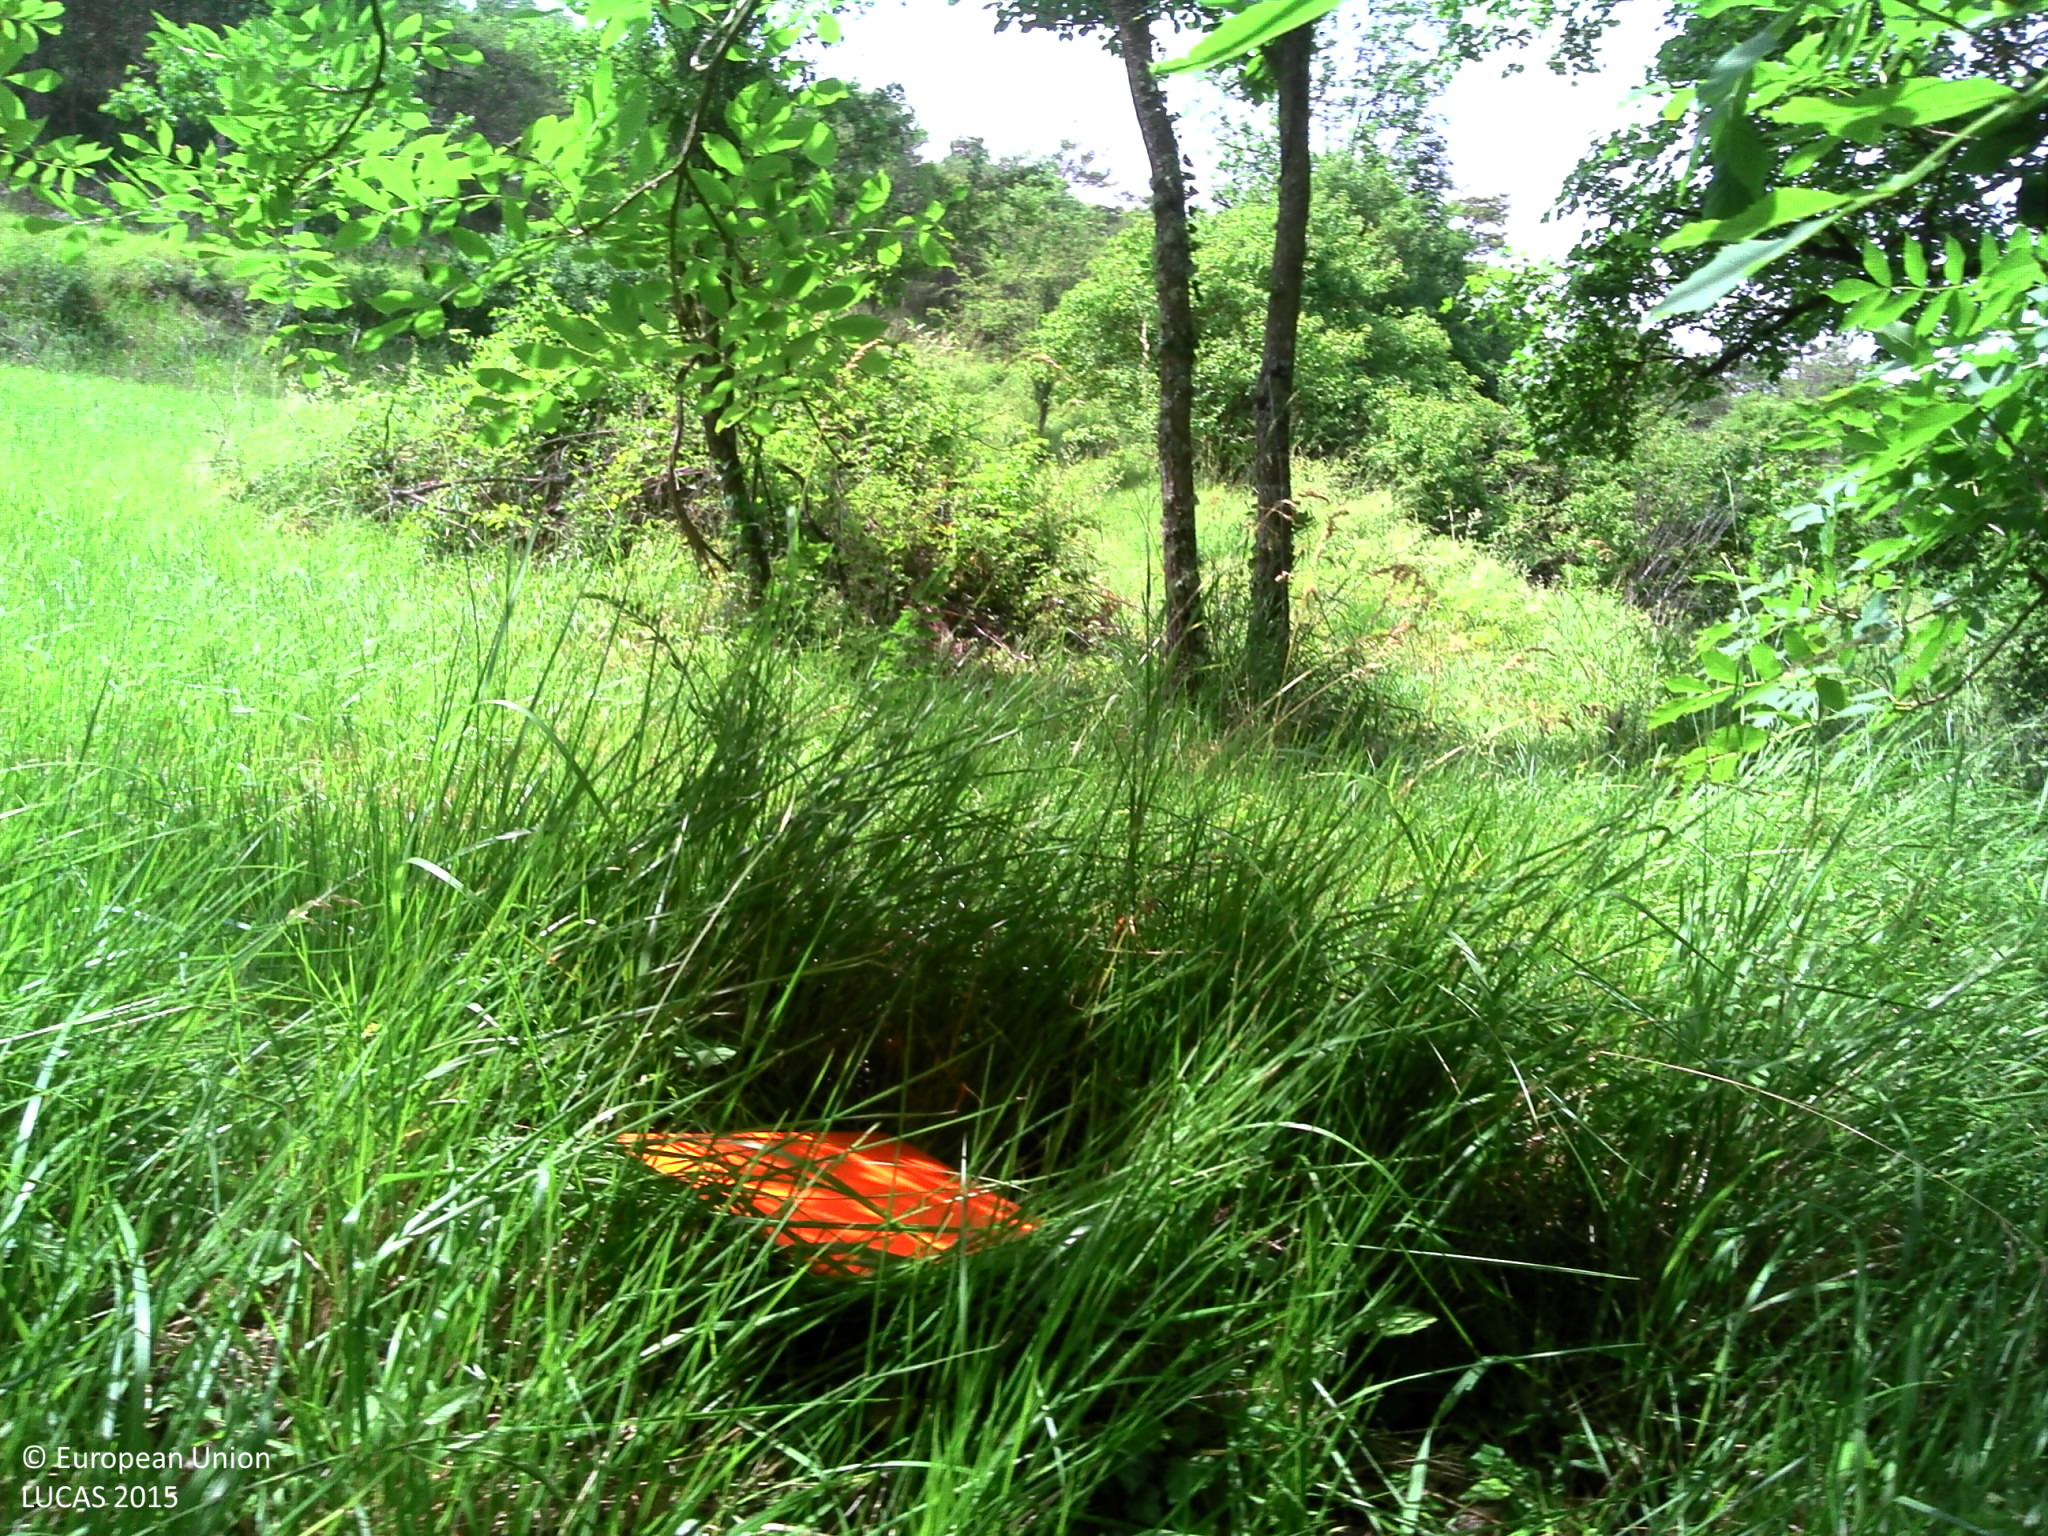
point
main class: Woodland
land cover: Broadleaved woodland
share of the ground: > 75 %
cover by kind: herbaceous plants 85 %, broadleaved forest trees 10 %, shrubs 5 %
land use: Agriculture (excluding fallow land and kitchen gardens)
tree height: > 5 m
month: June
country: FR
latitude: 44.7462
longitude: 5.2195
